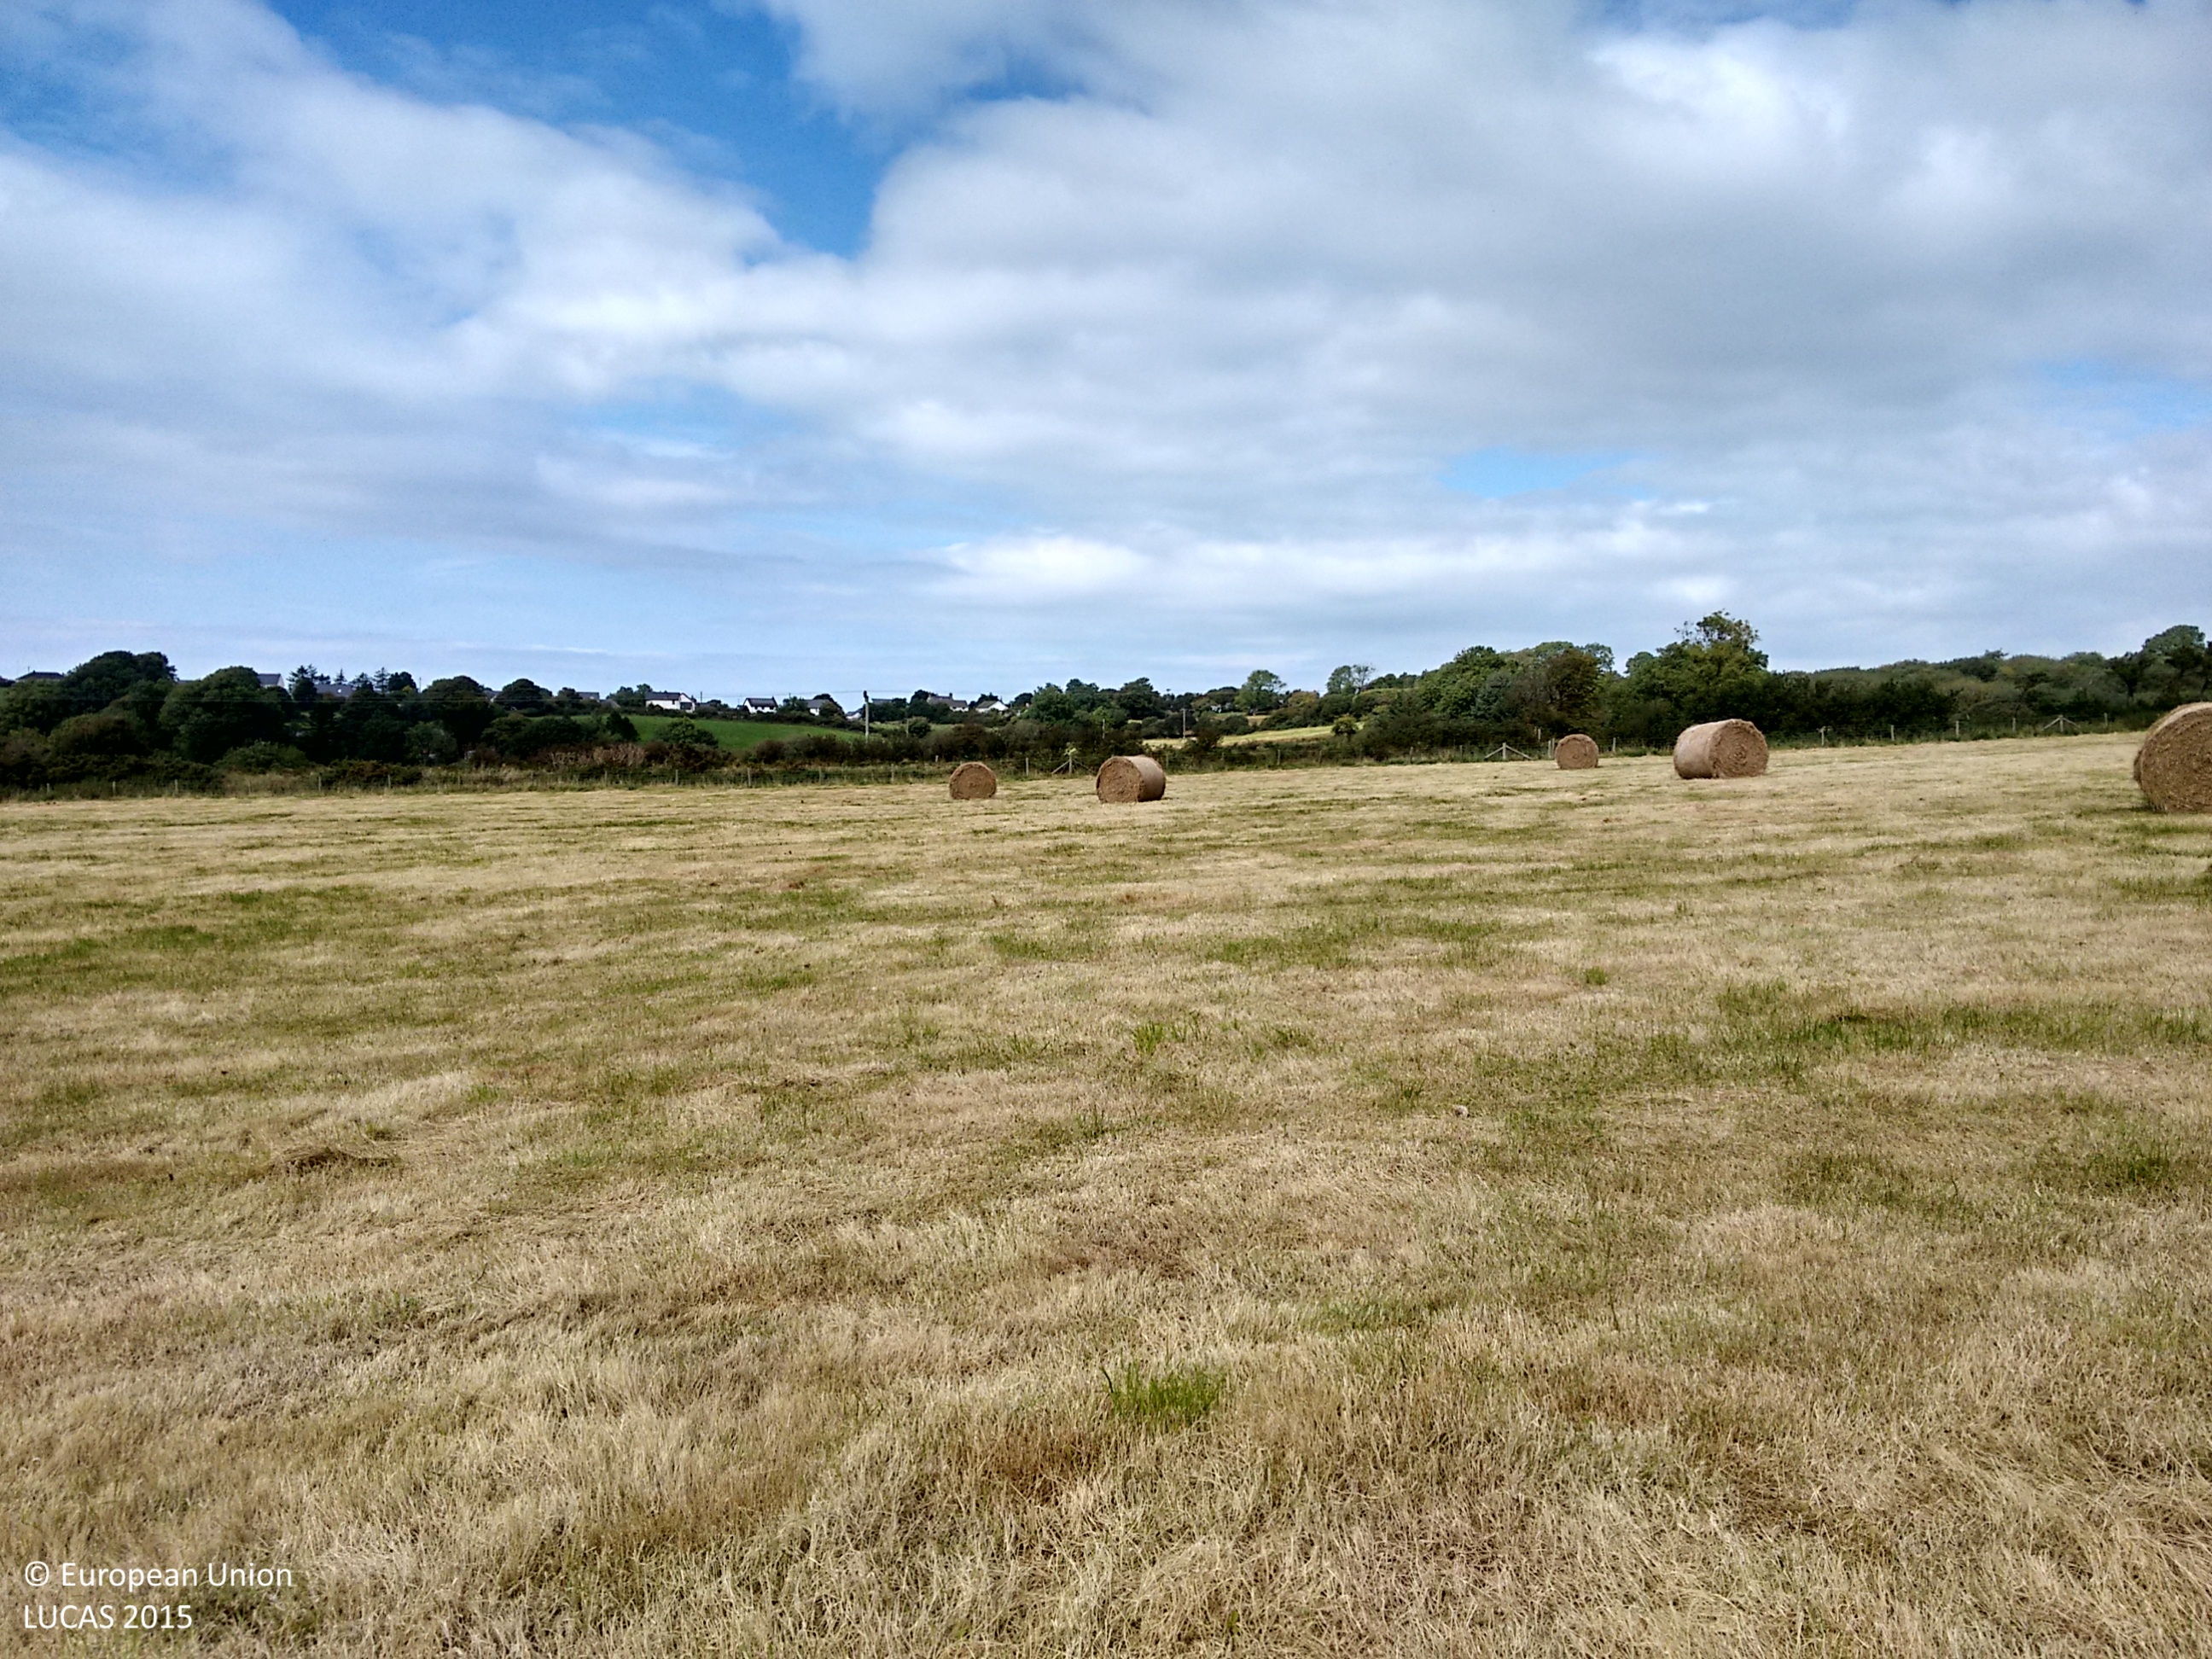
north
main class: Grassland
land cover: Grassland without tree/shrub cover
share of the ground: > 75 %
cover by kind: herbaceous plants 100 %
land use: Agriculture (excluding fallow land and kitchen gardens)
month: September
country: GB
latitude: 52.1251
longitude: -4.4630
